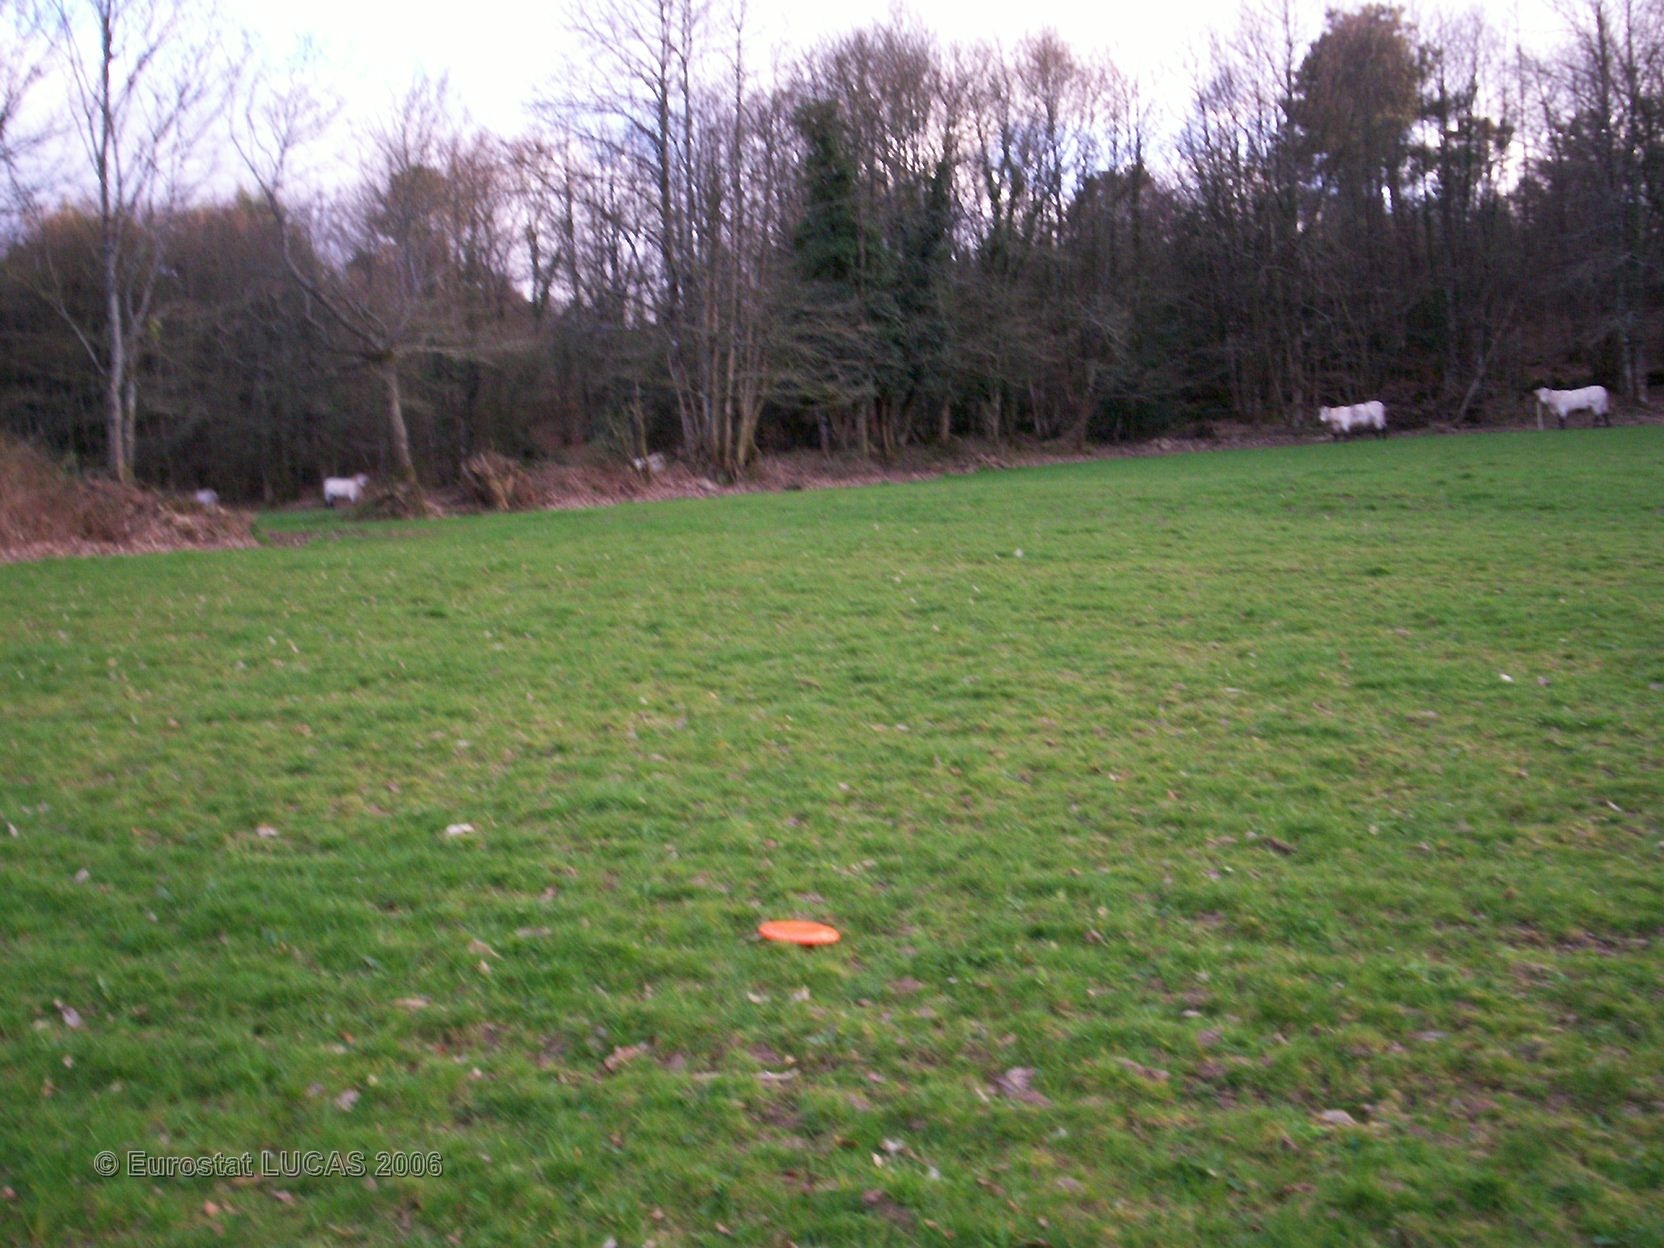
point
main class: Grassland
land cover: Grassland without tree/shrub cover
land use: Agriculture (excluding fallow land and kitchen gardens)
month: April
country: FR
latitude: 48.0237
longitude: -3.5262
